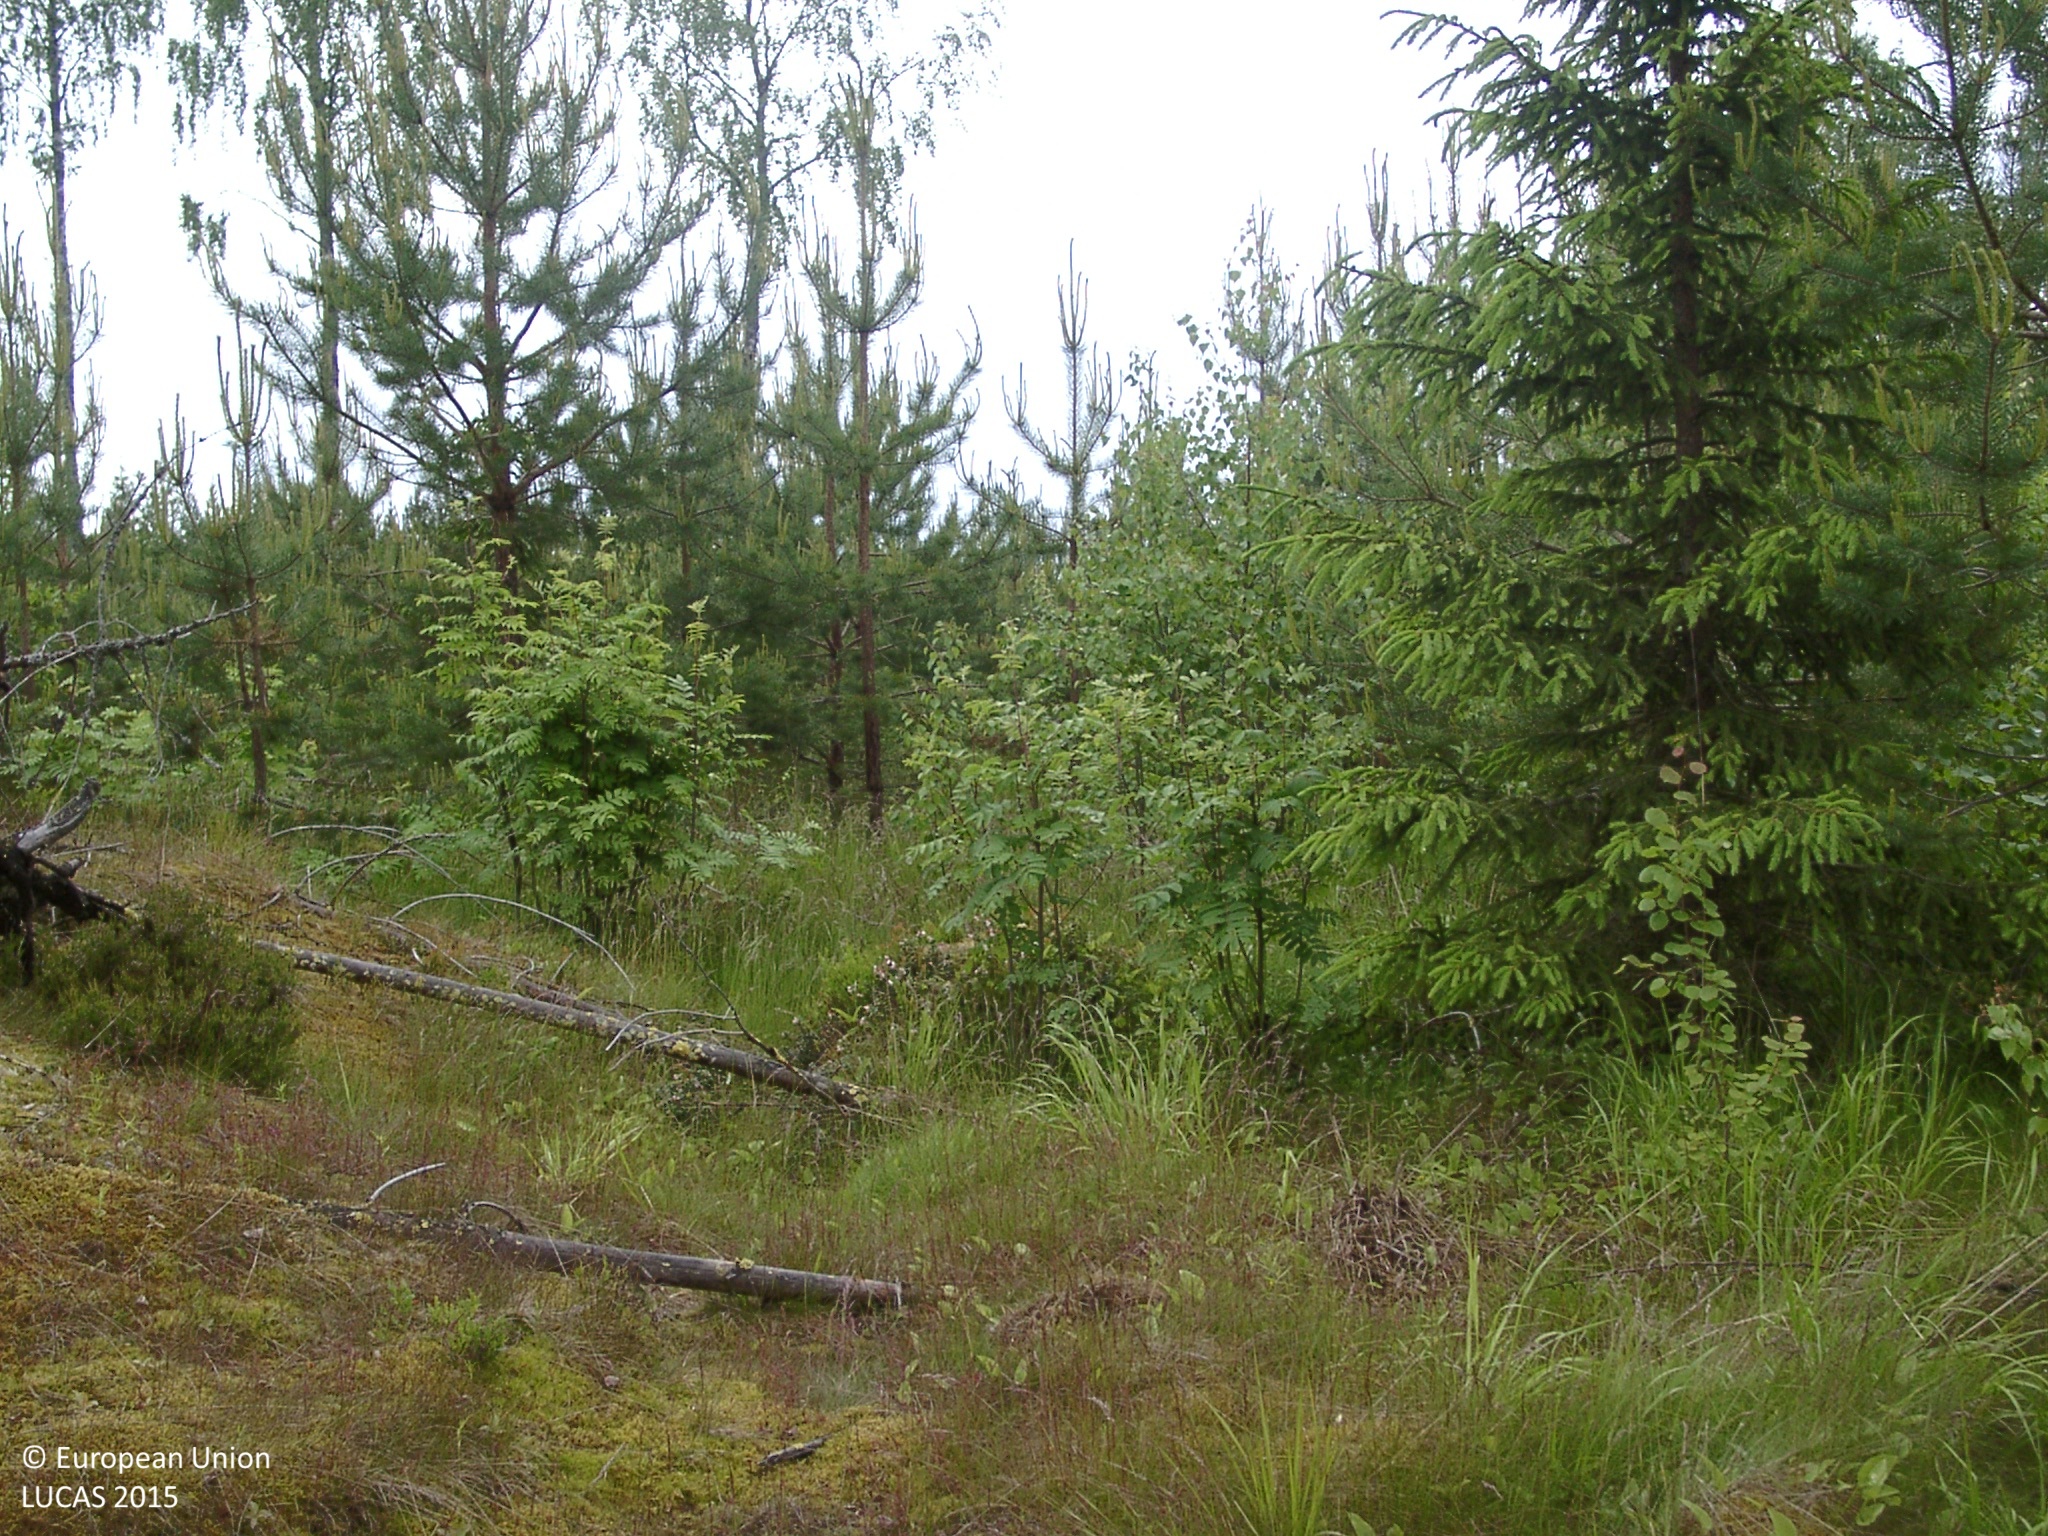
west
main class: Woodland
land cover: Other mixed woodland
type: boreal forest
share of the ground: 50 - 75 %
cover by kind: coniferous forest trees 35 %, broadleaved forest trees 35 %, herbaceous plants 15 %, shrubs 10 %, lichens and mosses 5 %
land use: Forestry
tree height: < 5 m
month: June
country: FI
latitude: 61.5716
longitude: 24.8878
